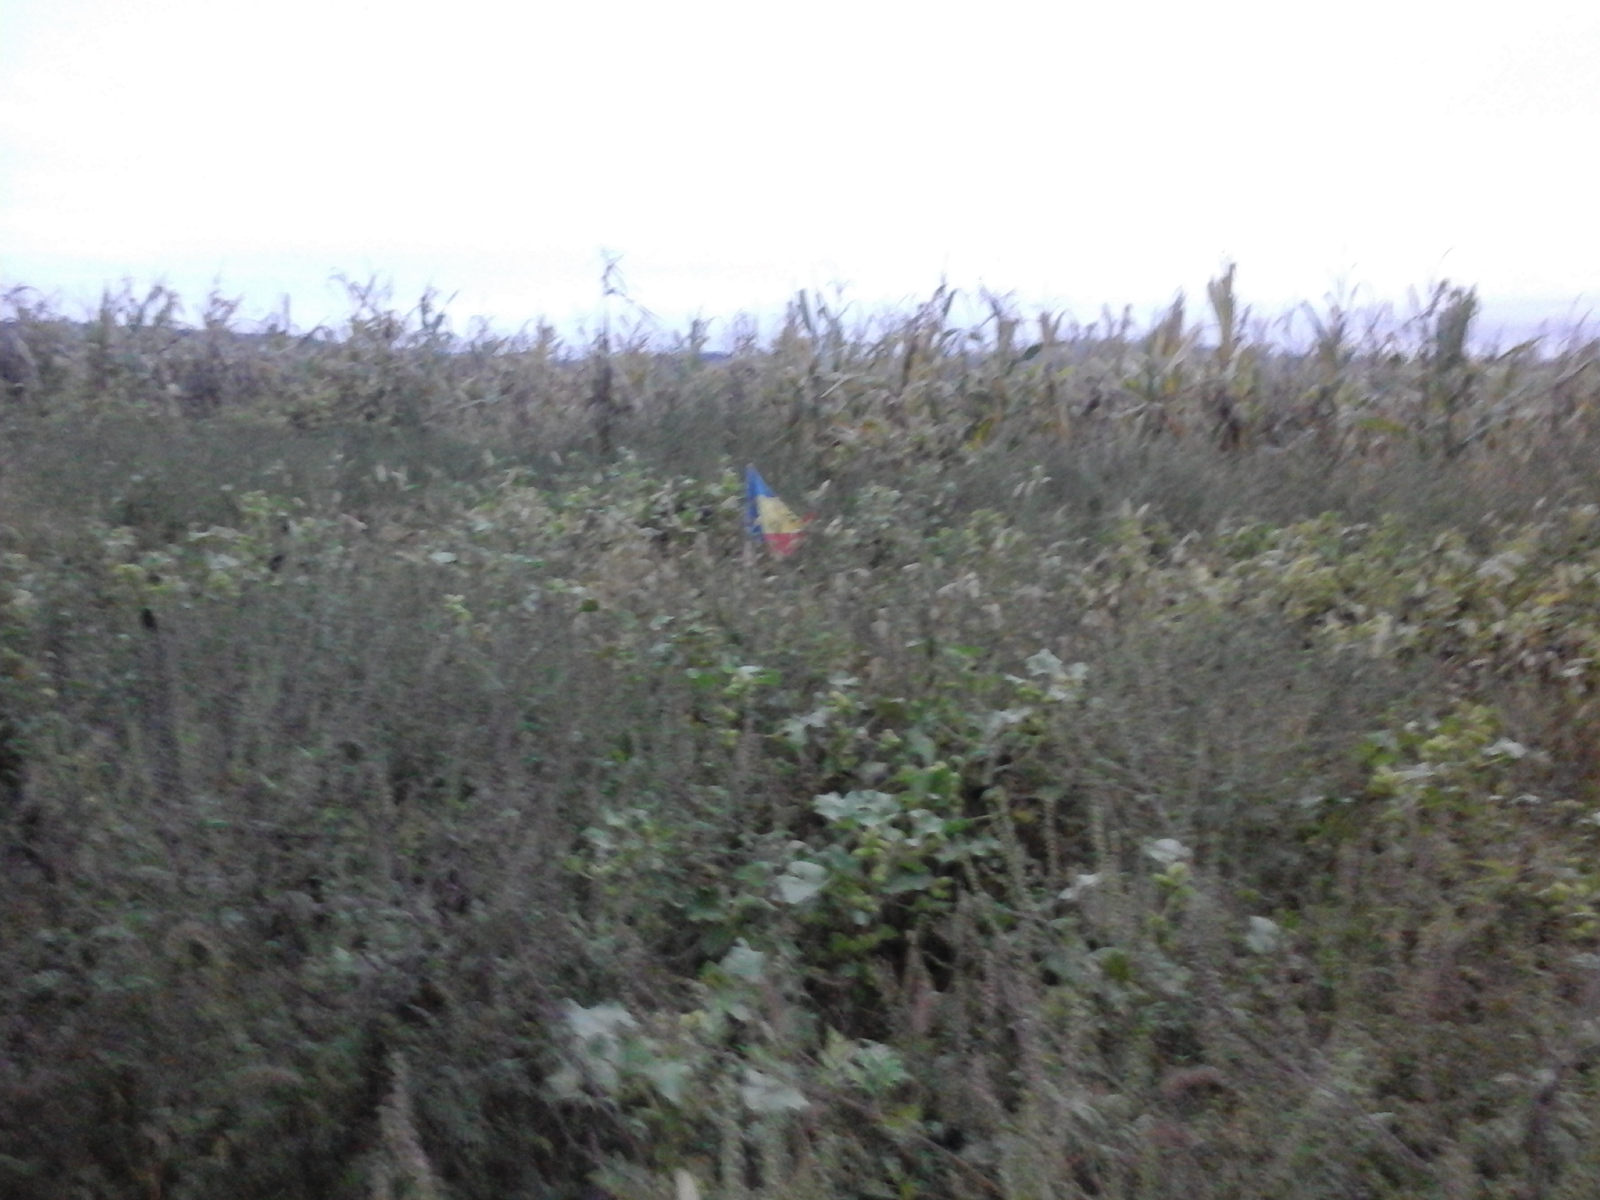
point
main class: Grassland
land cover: Spontaneously vegetated surfaces
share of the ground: > 75 %
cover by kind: herbaceous plants 100 %
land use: Fallow land
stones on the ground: < 10 %
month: September
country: RO
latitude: 46.0264
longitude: 23.5920
